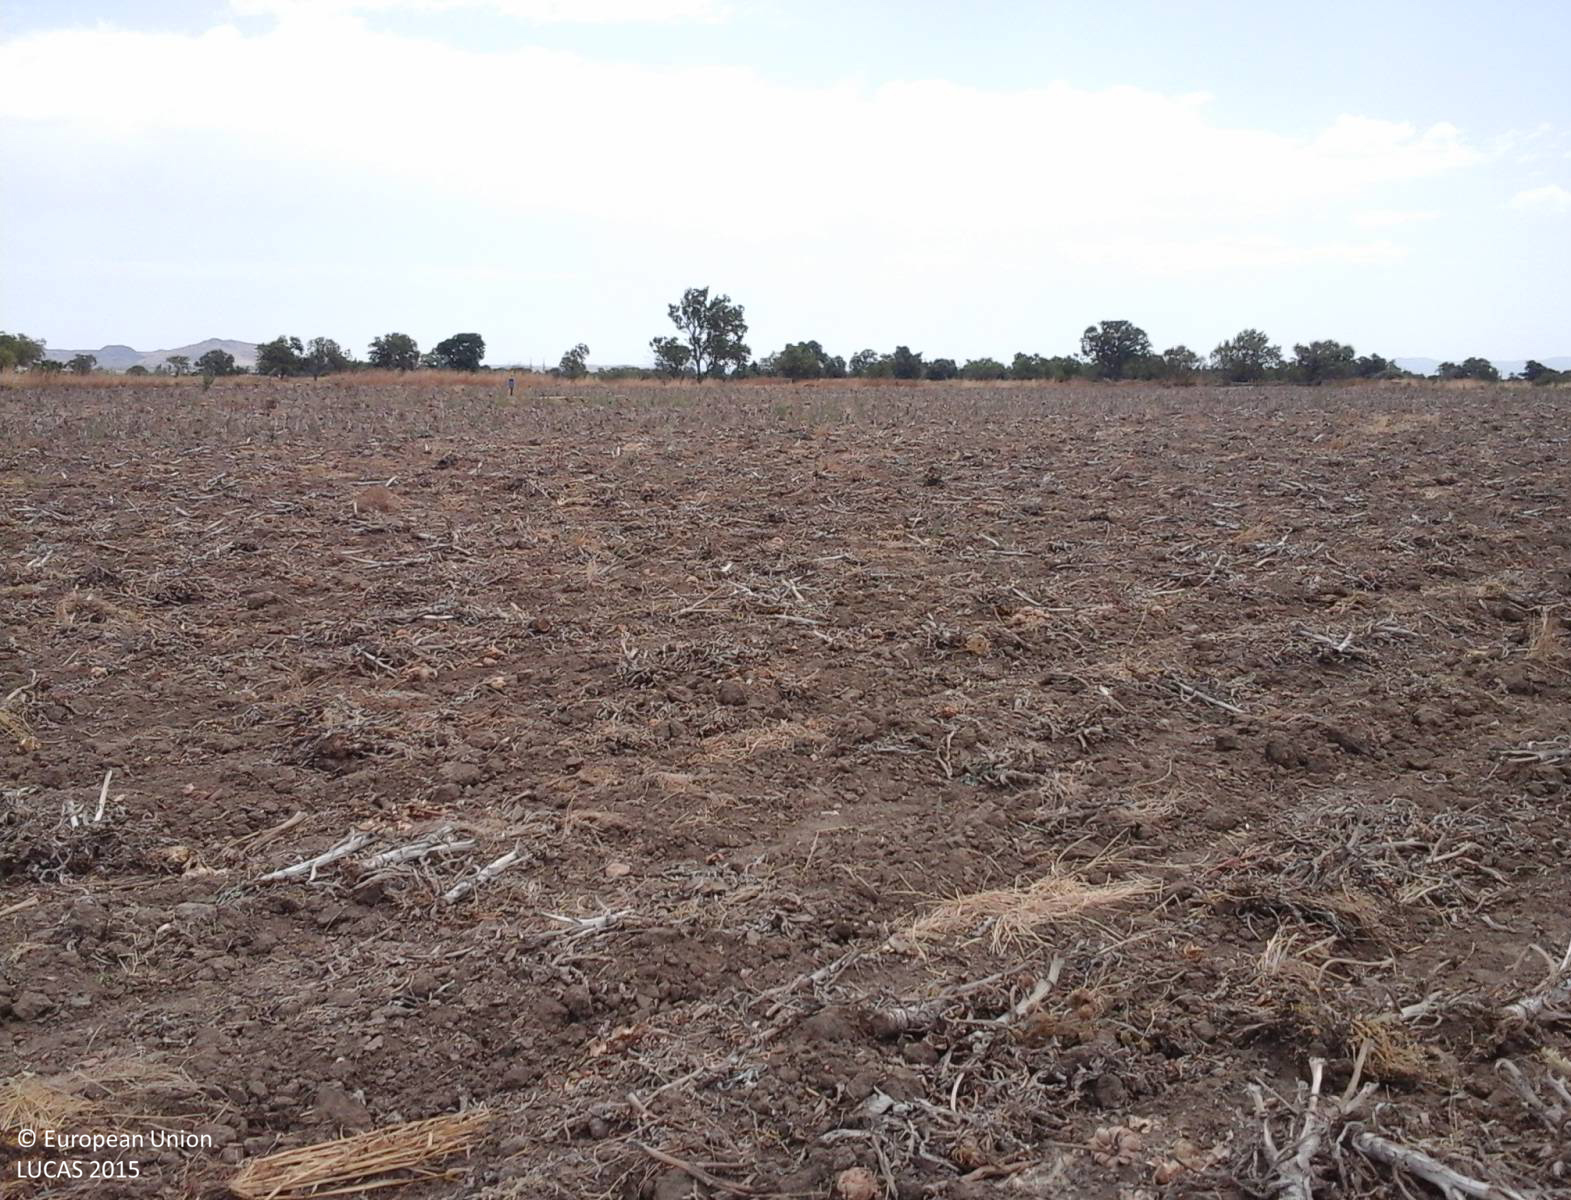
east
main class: Cropland
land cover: Other fresh vegetables
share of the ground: > 75 %
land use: Agriculture (excluding fallow land and kitchen gardens)
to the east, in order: Other fresh vegetables; Abandoned hedges; Other fresh vegetables; Grass margins; Abandoned hedges; Durum wheat; Abandoned hedges; Grassland without tree/shrub cover
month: July
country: IT
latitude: 39.4821
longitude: 8.8790
